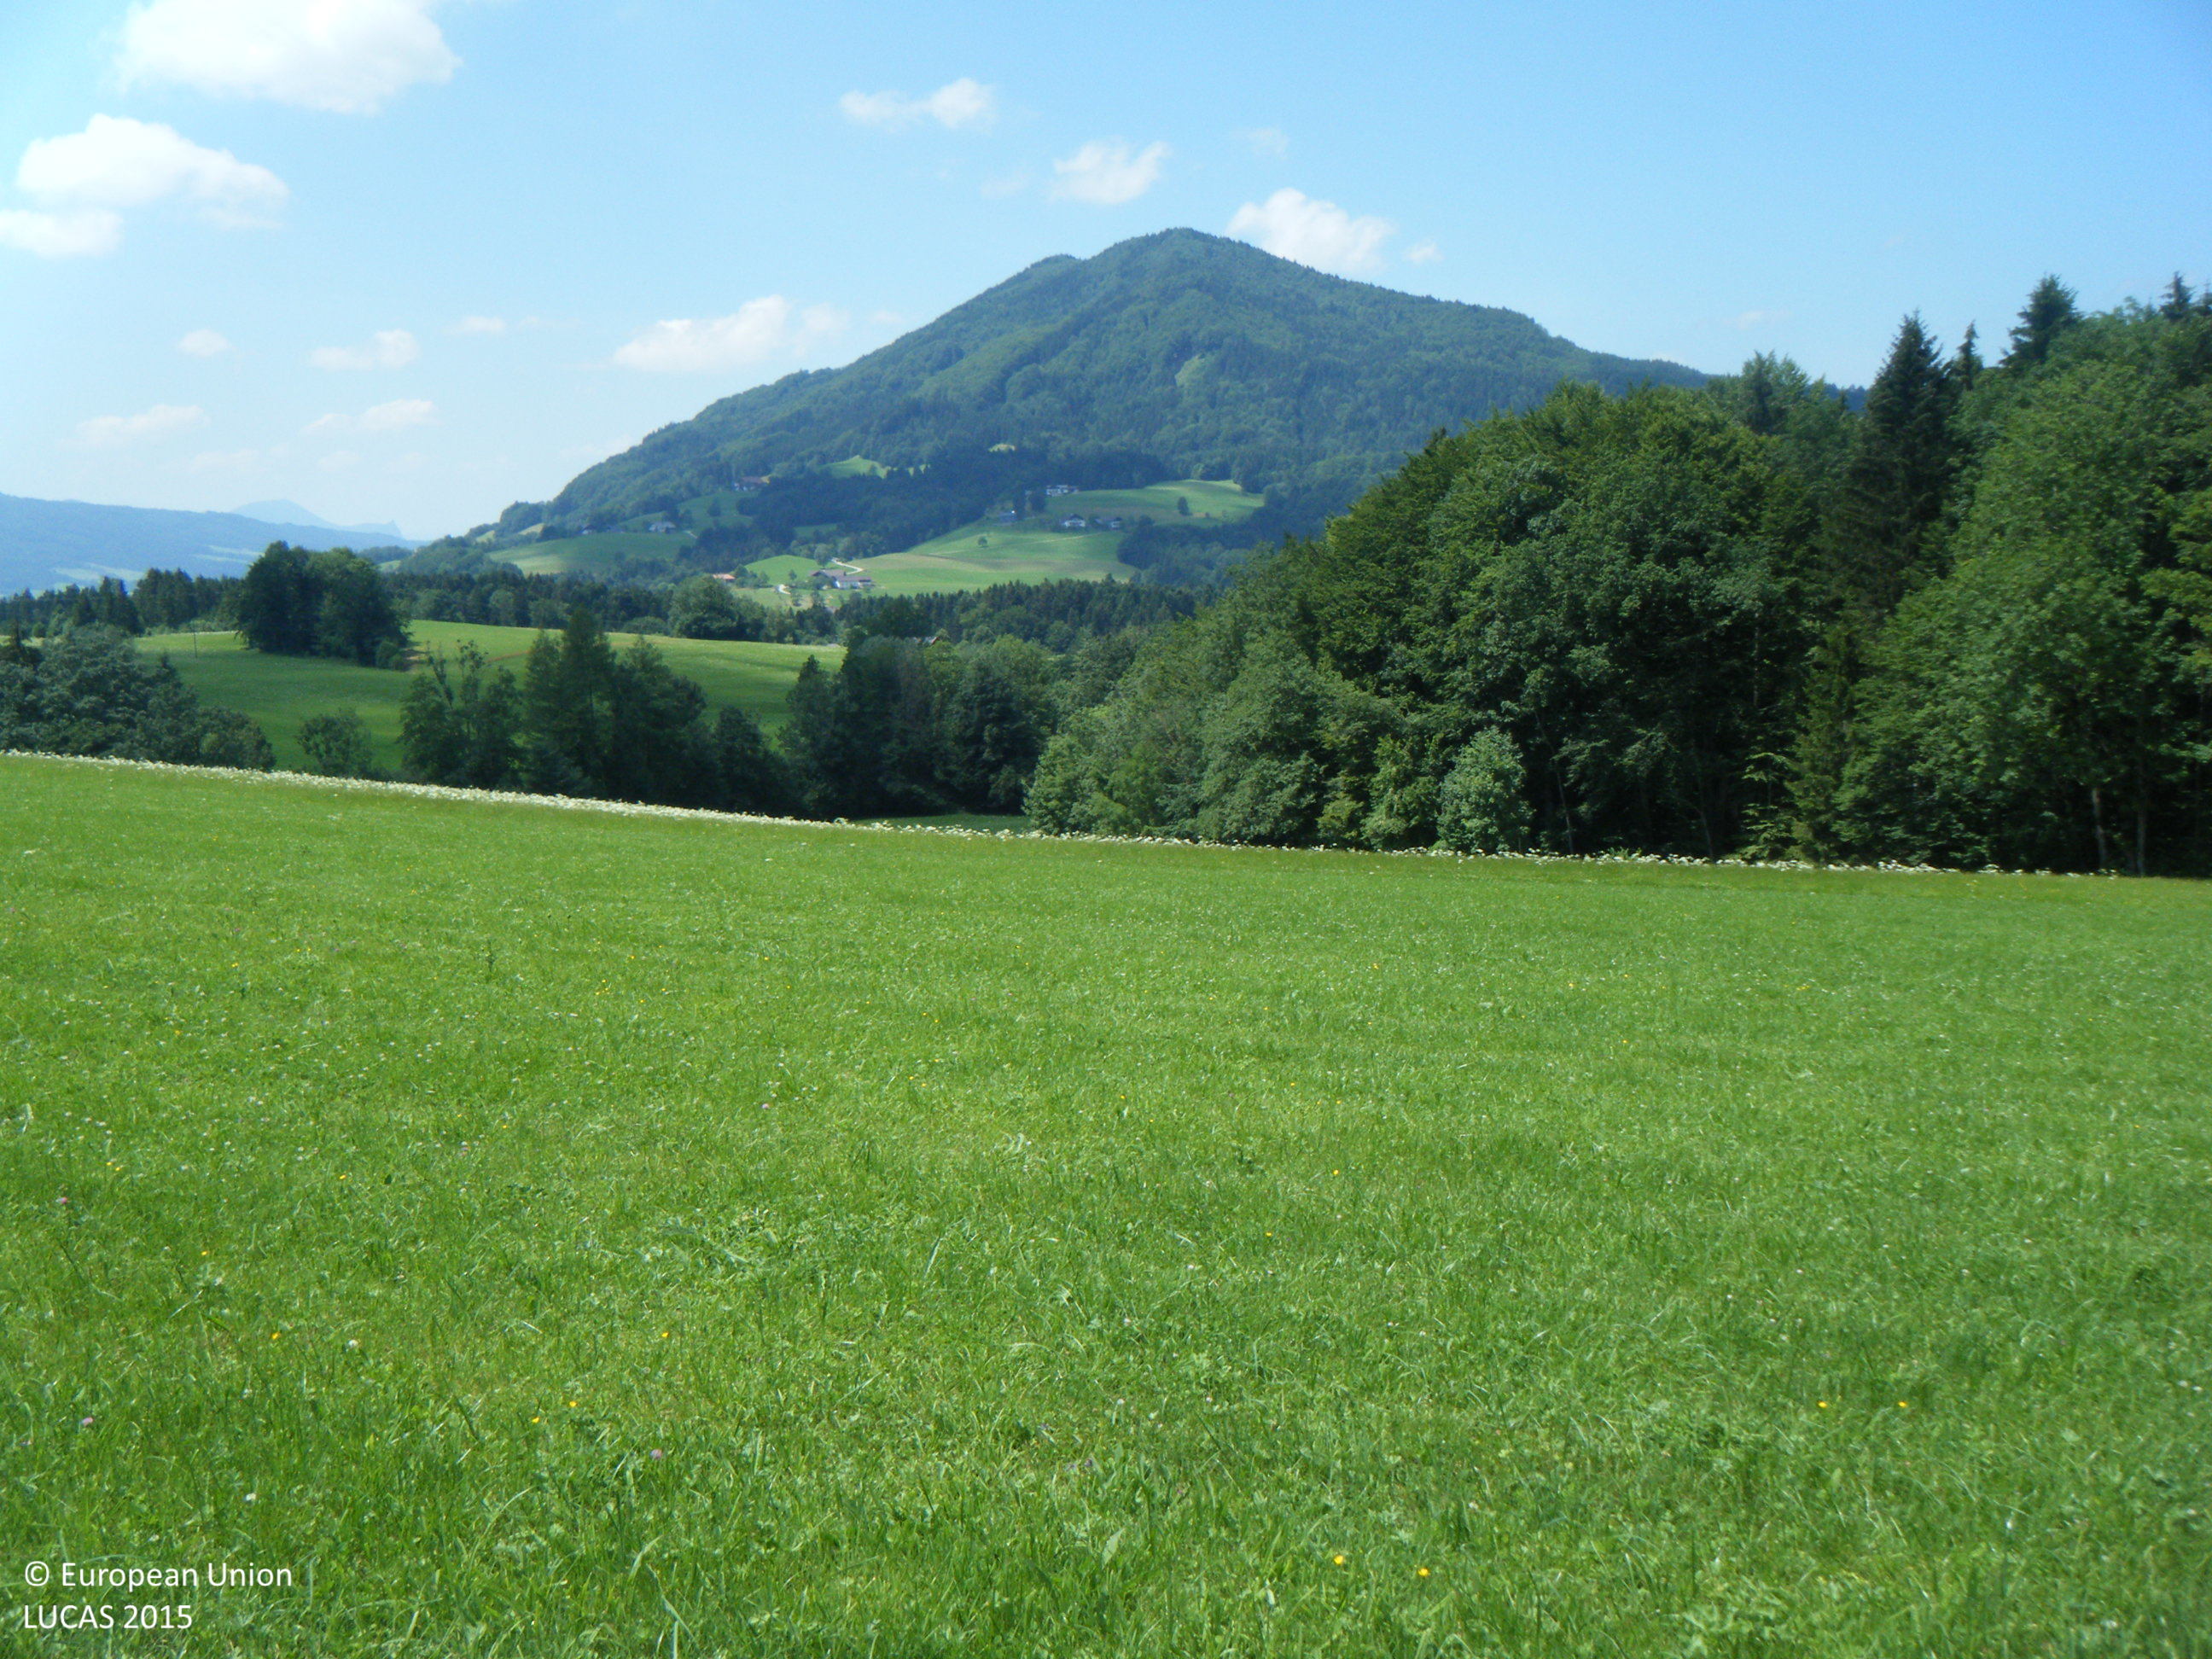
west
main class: Grassland
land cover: Grassland without tree/shrub cover
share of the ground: > 75 %
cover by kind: herbaceous plants 100 %
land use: Agriculture (excluding fallow land and kitchen gardens)
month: July
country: AT
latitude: 47.8451
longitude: 13.4598
